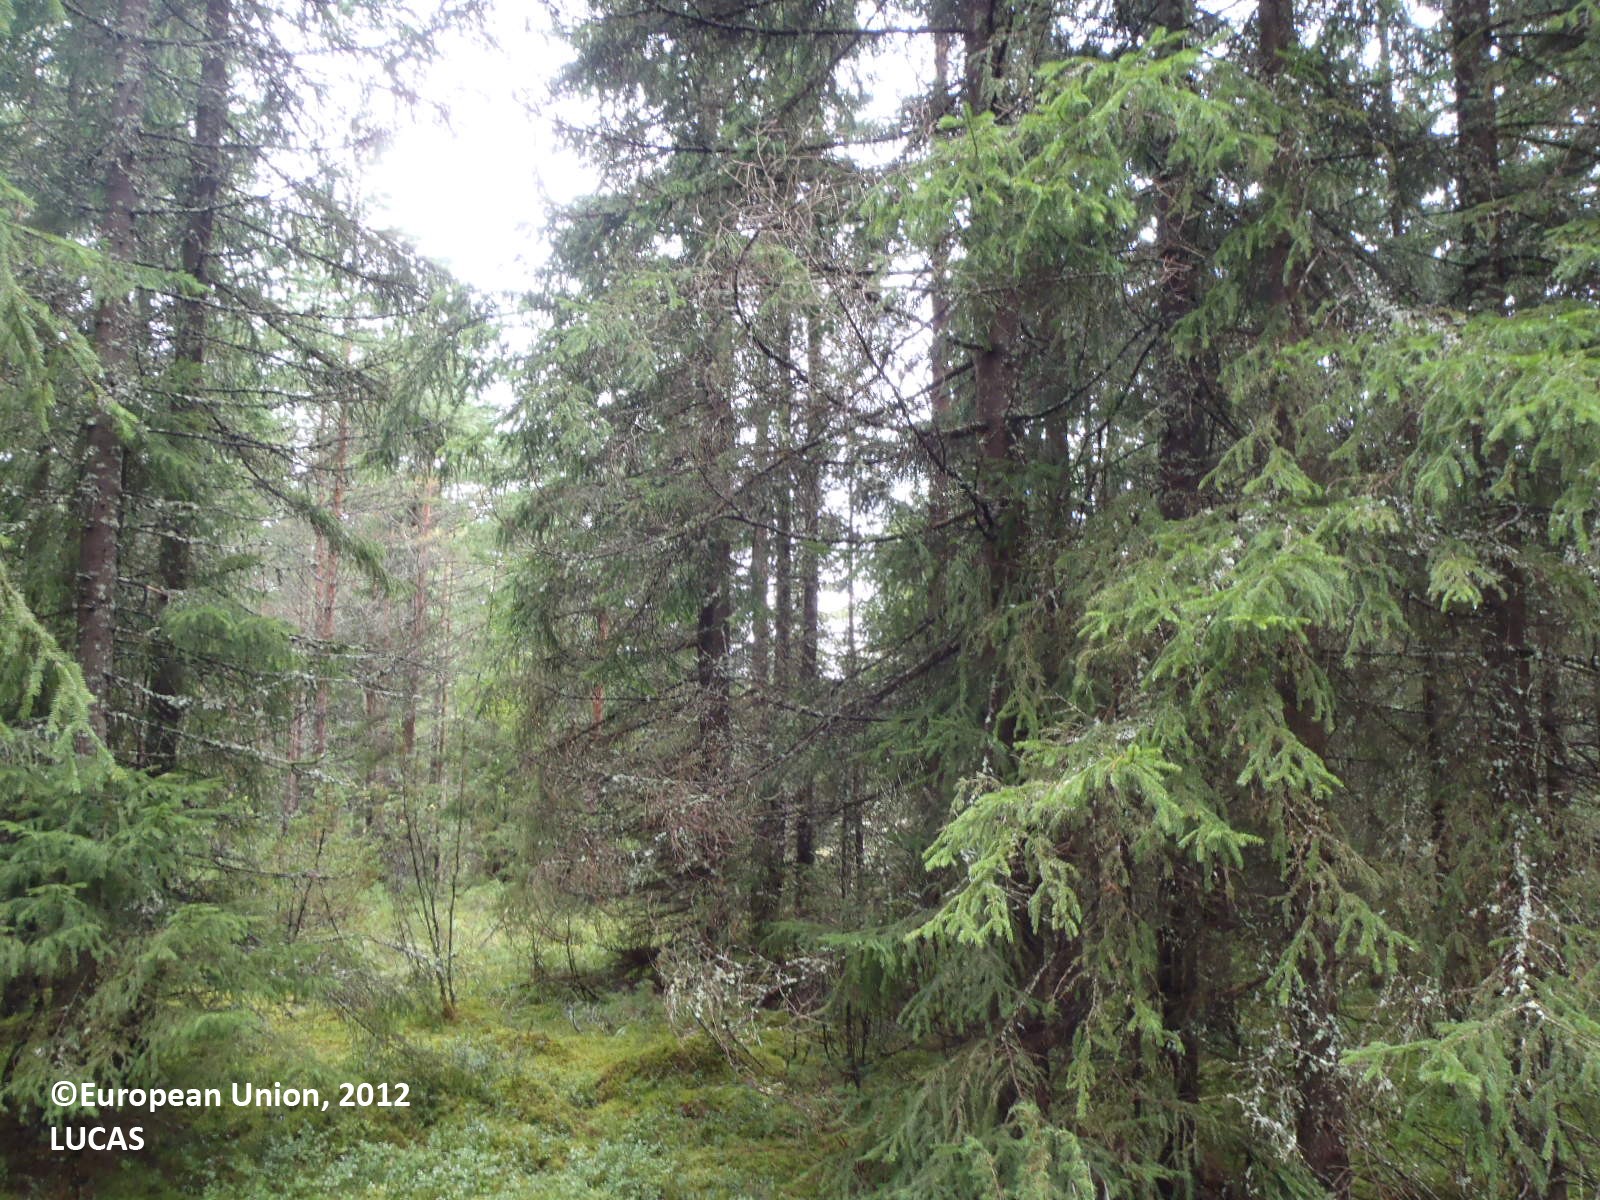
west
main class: Woodland
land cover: Spruce dominated coniferous woodland
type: boreal forest
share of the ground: > 75 %
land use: Forestry
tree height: > 5 m
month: August
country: FI
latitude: 60.7271
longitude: 22.1828
